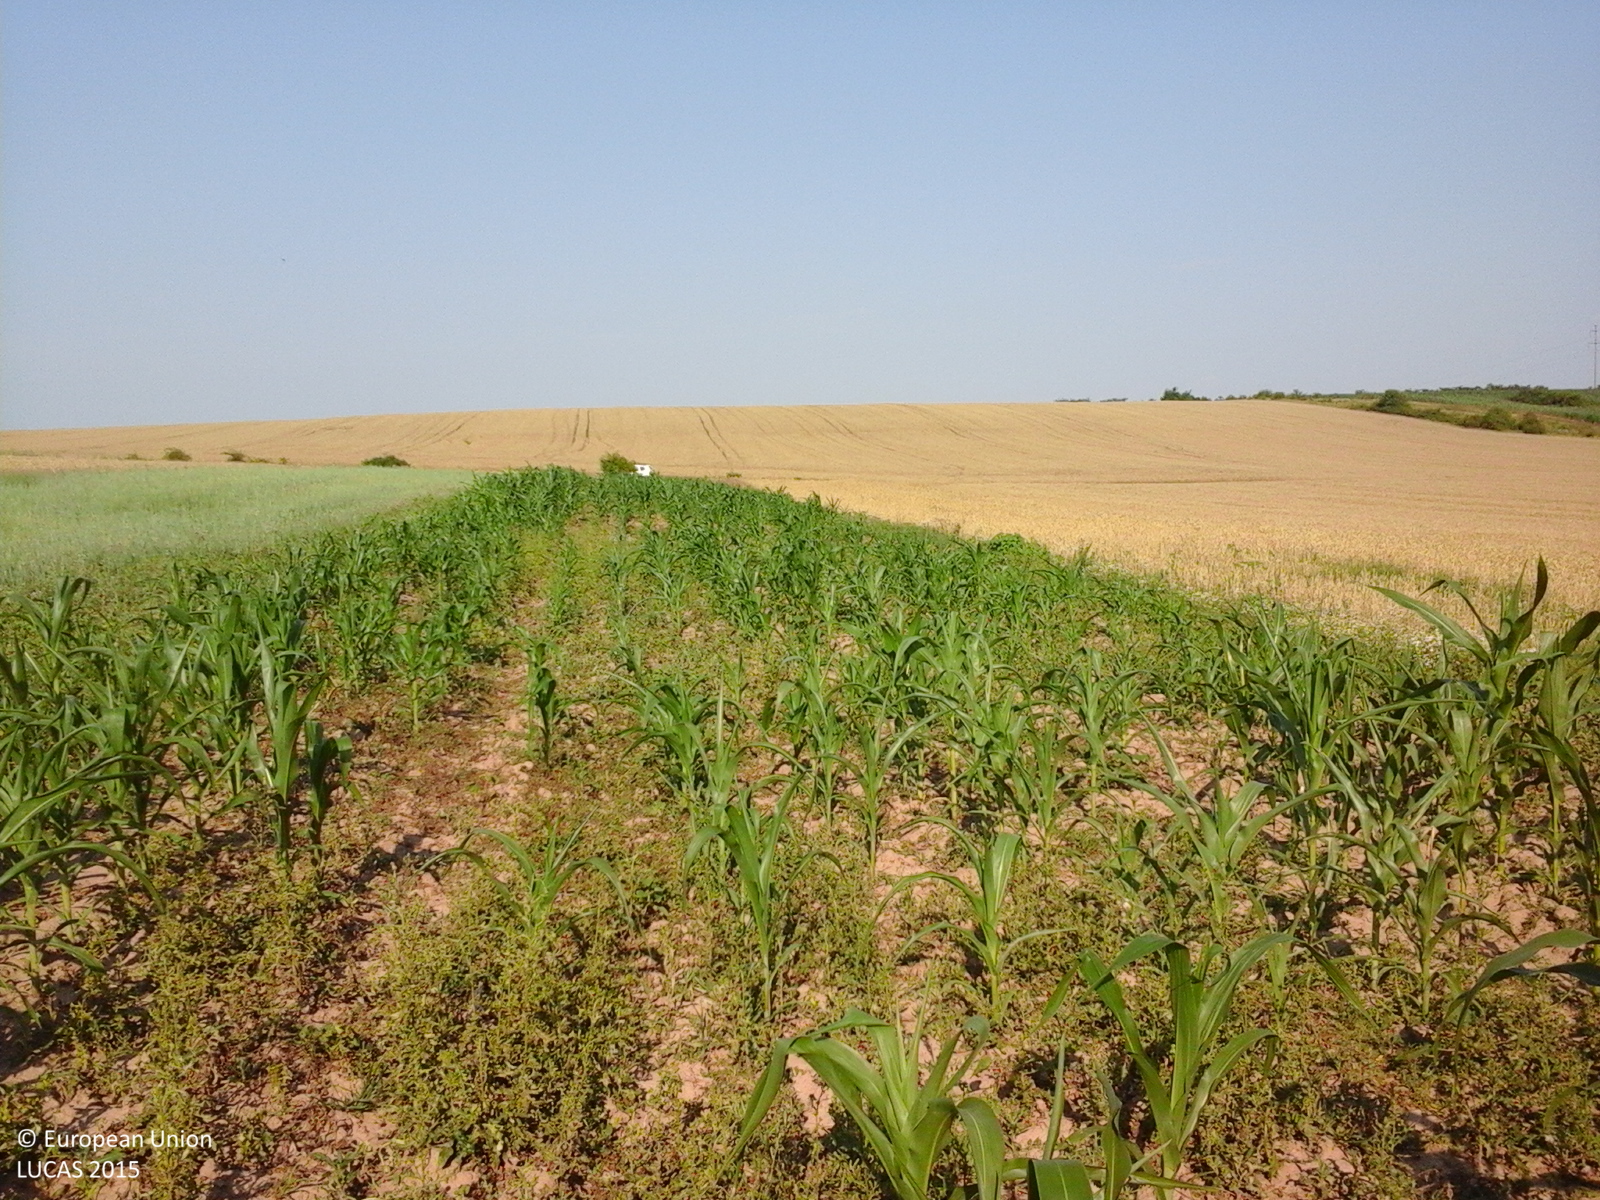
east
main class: Cropland
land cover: Maize
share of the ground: 50 - 75 %
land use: Agriculture (excluding fallow land and kitchen gardens)
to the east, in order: Maize; Common wheat; Grassland without tree/shrub cover; Single bushes/trees; Tracks; Common wheat
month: July
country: RO
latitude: 44.6741
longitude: 24.6710
